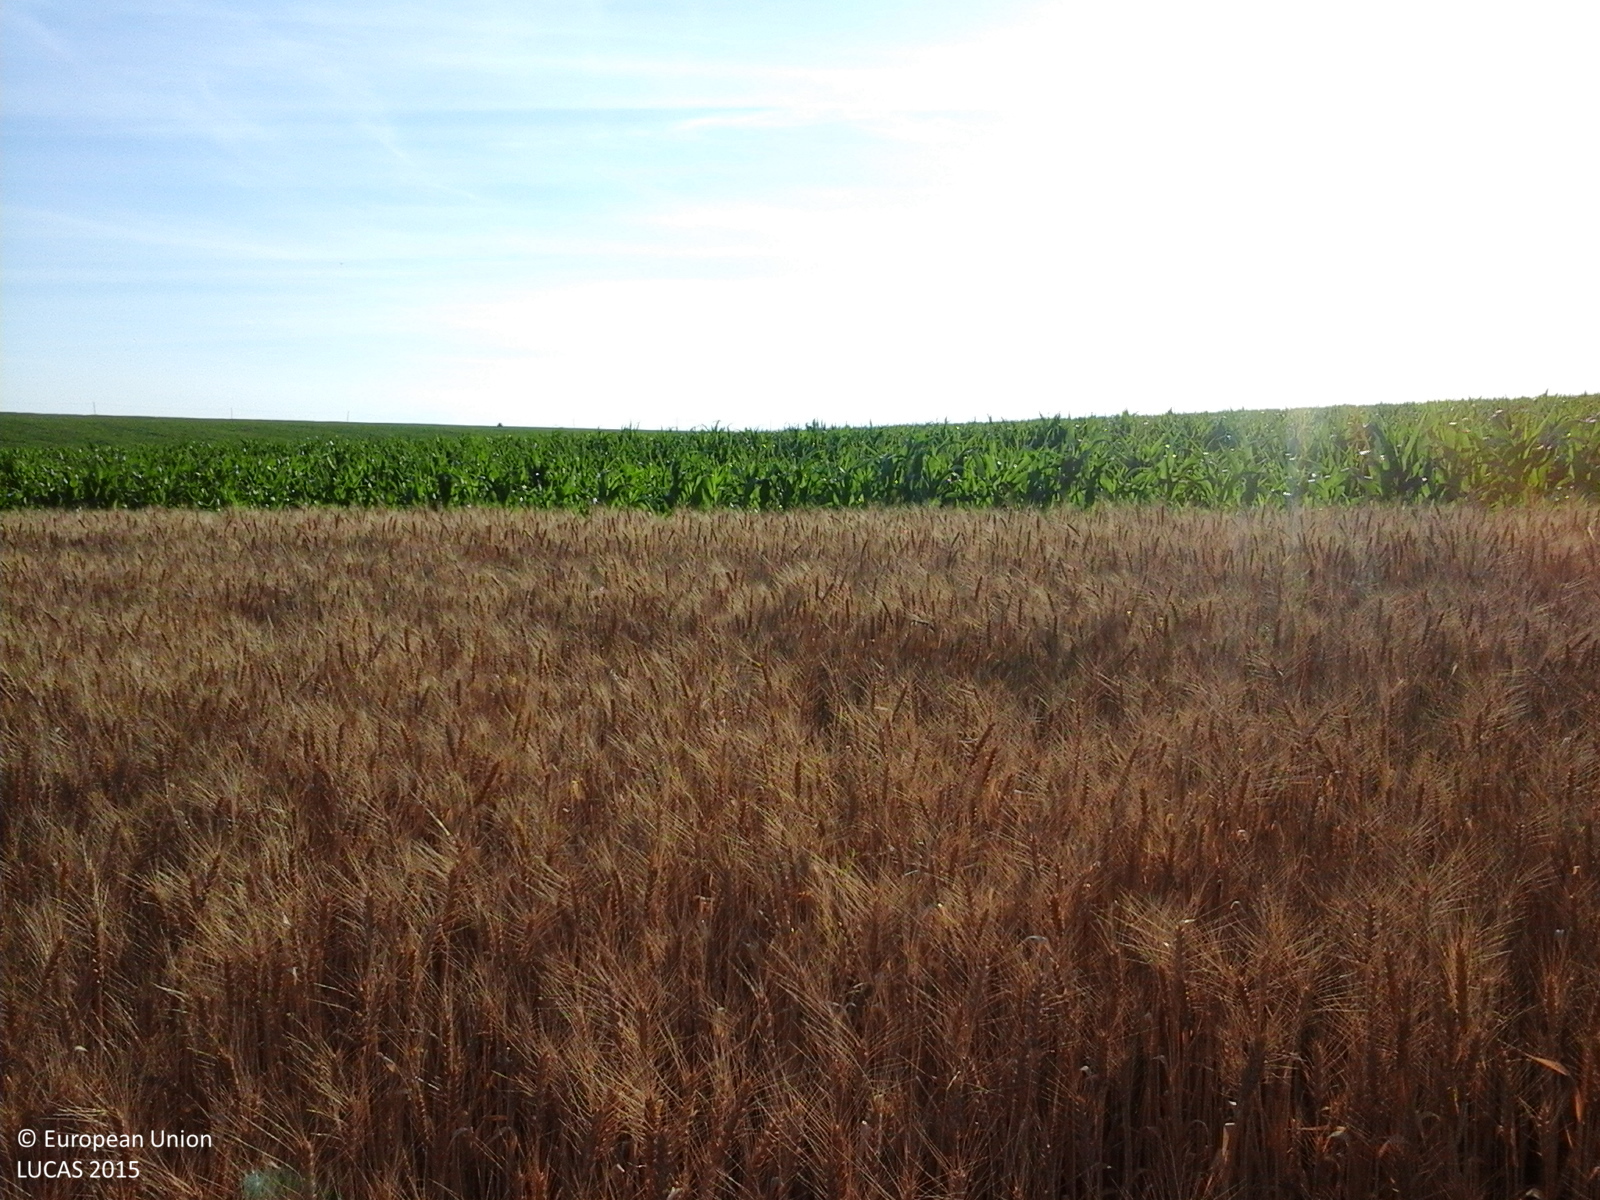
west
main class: Cropland
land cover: Common wheat
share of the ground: > 75 %
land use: Agriculture (excluding fallow land and kitchen gardens)
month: June
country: RO
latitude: 47.4104
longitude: 27.0817
